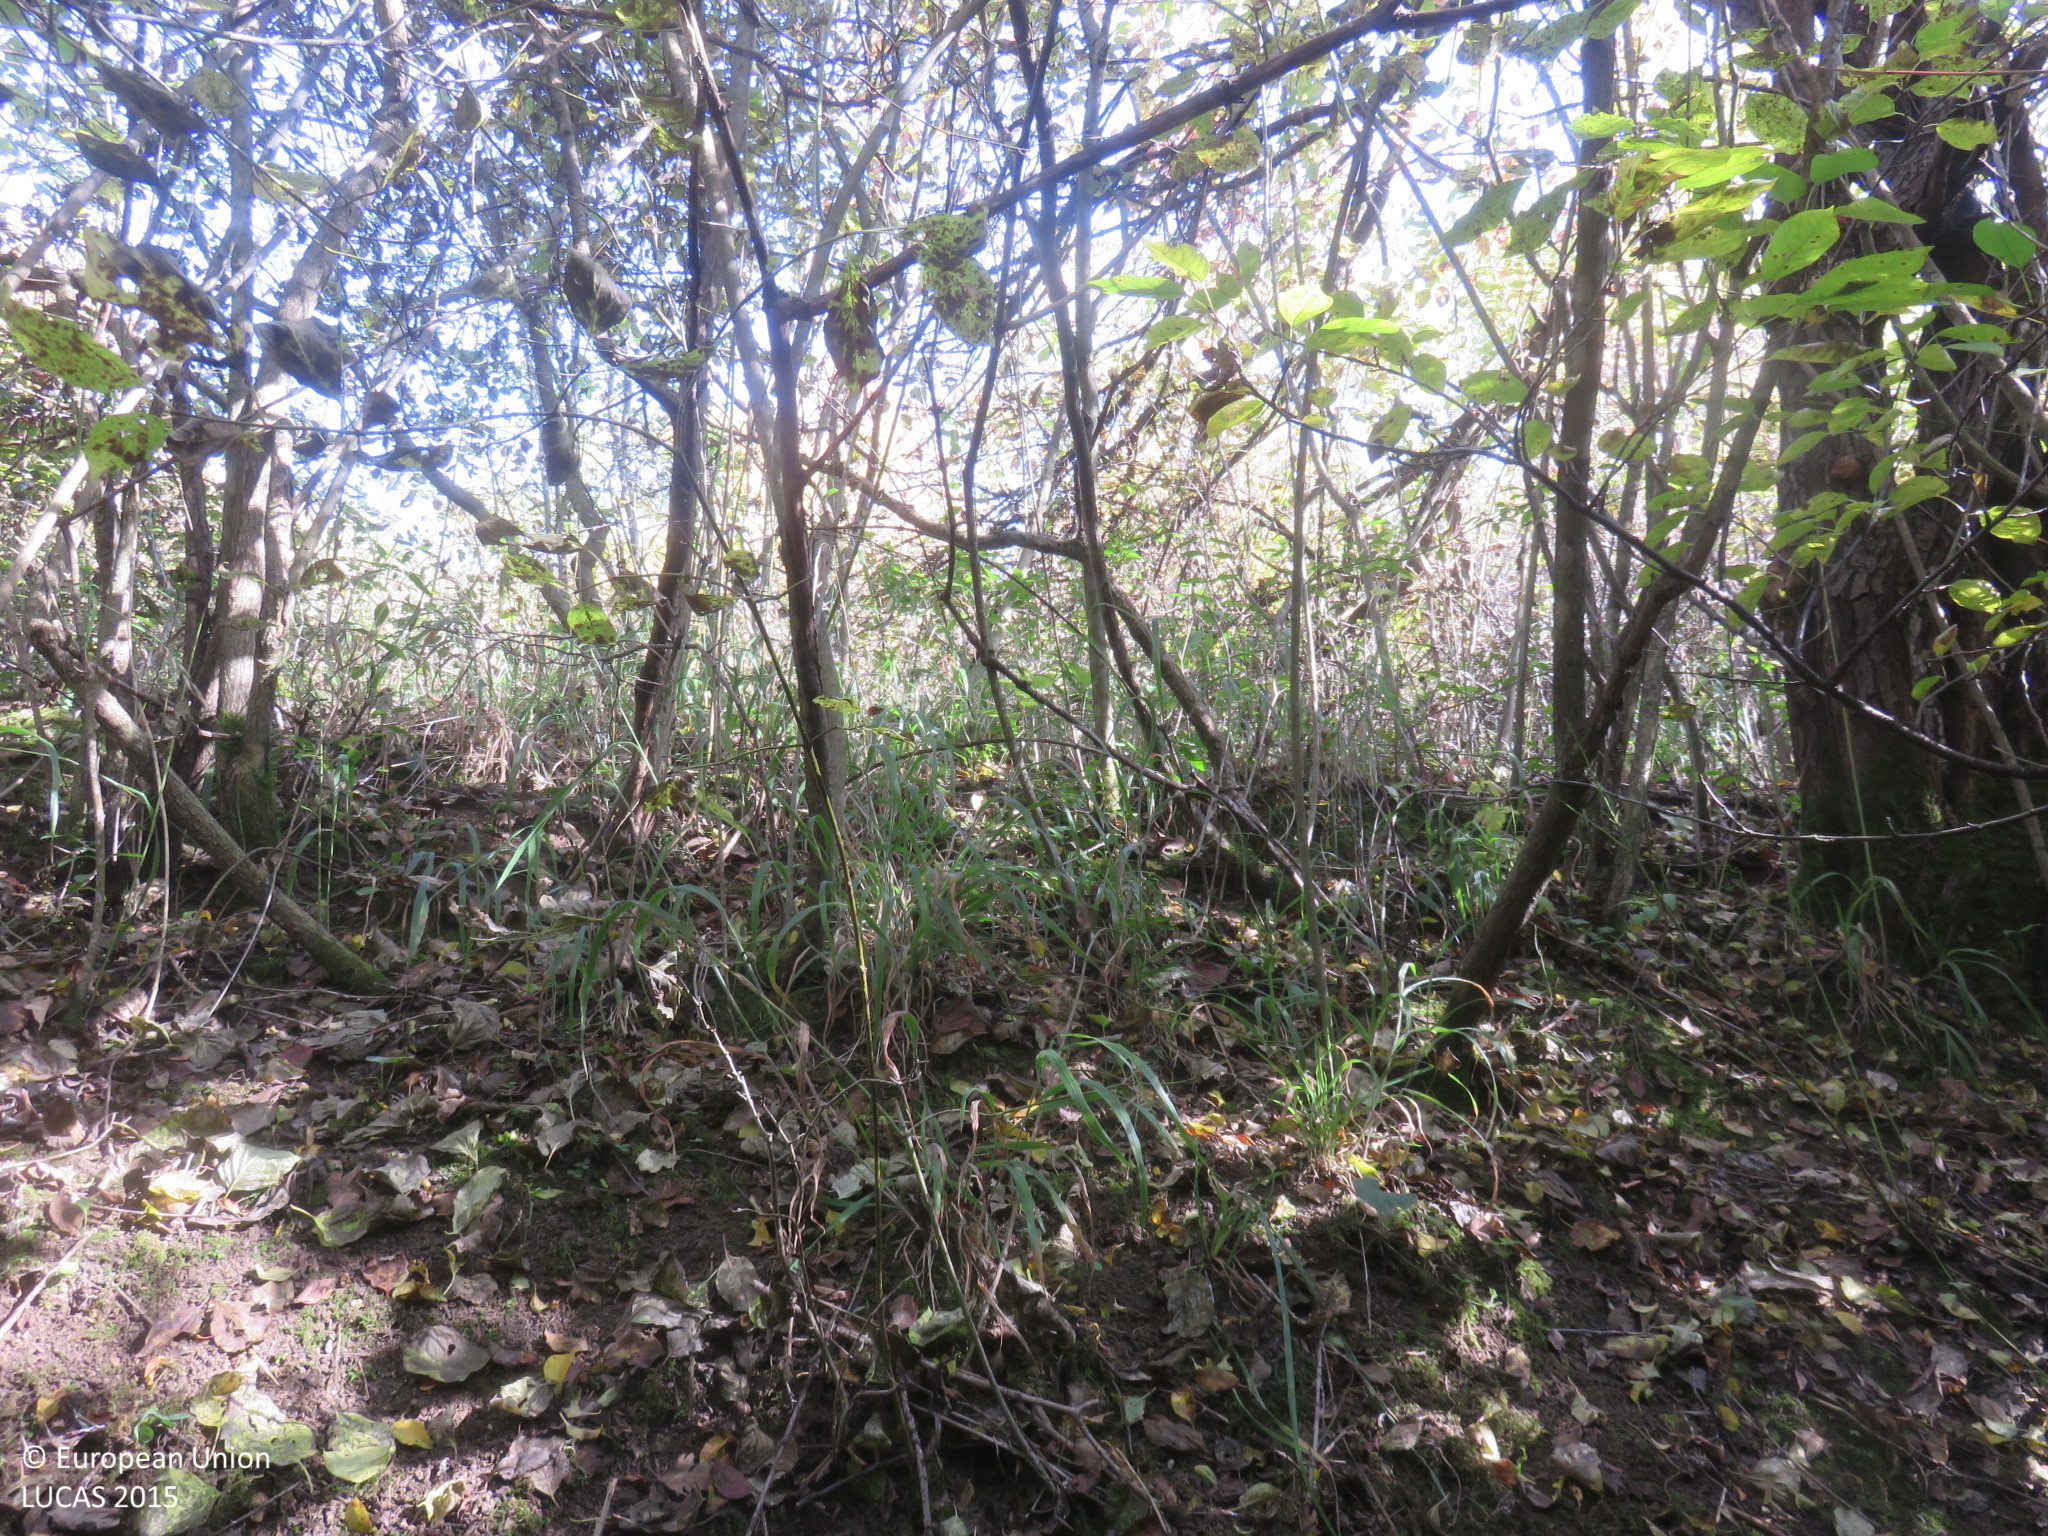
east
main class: Woodland
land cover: Broadleaved woodland
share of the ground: > 75 %
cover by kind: broadleaved forest trees 70 %, shrubs 30 %
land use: Semi-natural and natural areas not in use
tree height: < 5 m
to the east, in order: Broadleaved woodland; Grassland with sparse tree/shrub cover; Broadleaved woodland; Other bare soil; Grassland without tree/shrub cover; Broadleaved woodland
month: October
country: BG
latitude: 42.9657
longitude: 24.8355
